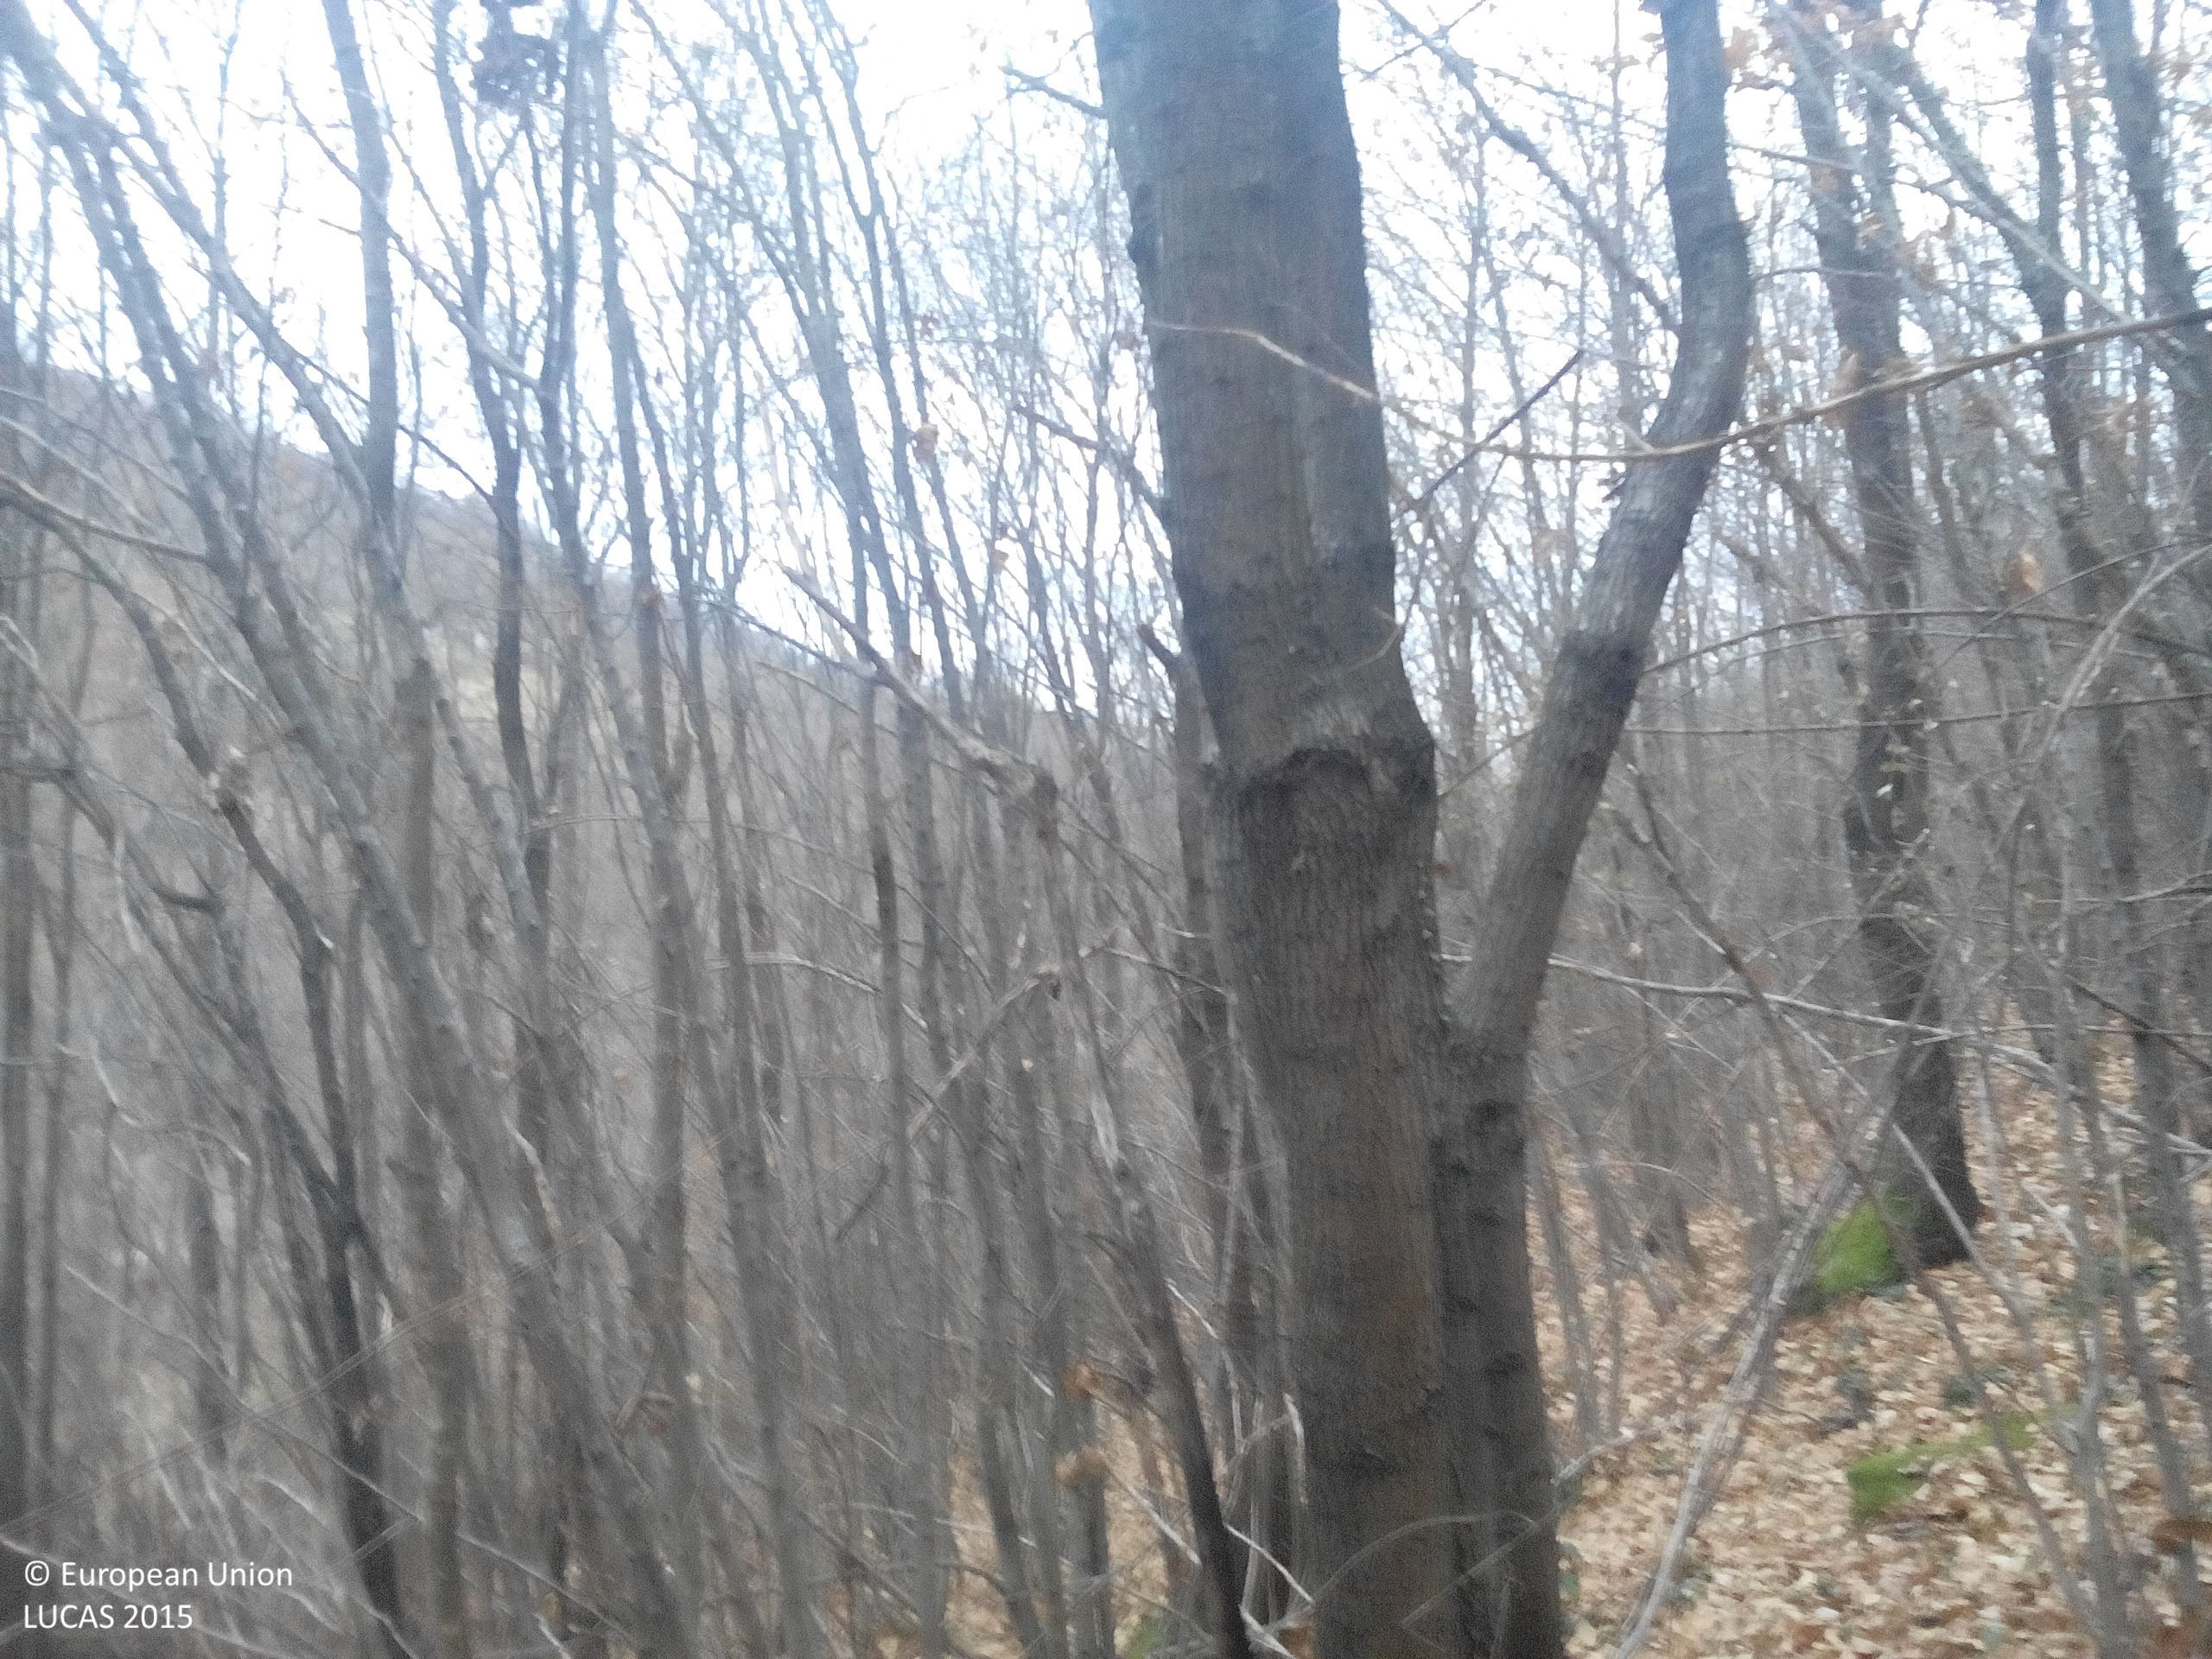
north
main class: Woodland
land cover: Broadleaved woodland
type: mesophytic deciduous forest
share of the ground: > 75 %
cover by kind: broadleaved forest trees 100 %
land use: Forestry
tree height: > 5 m
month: November
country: BG
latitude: 43.0809
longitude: 23.7647
